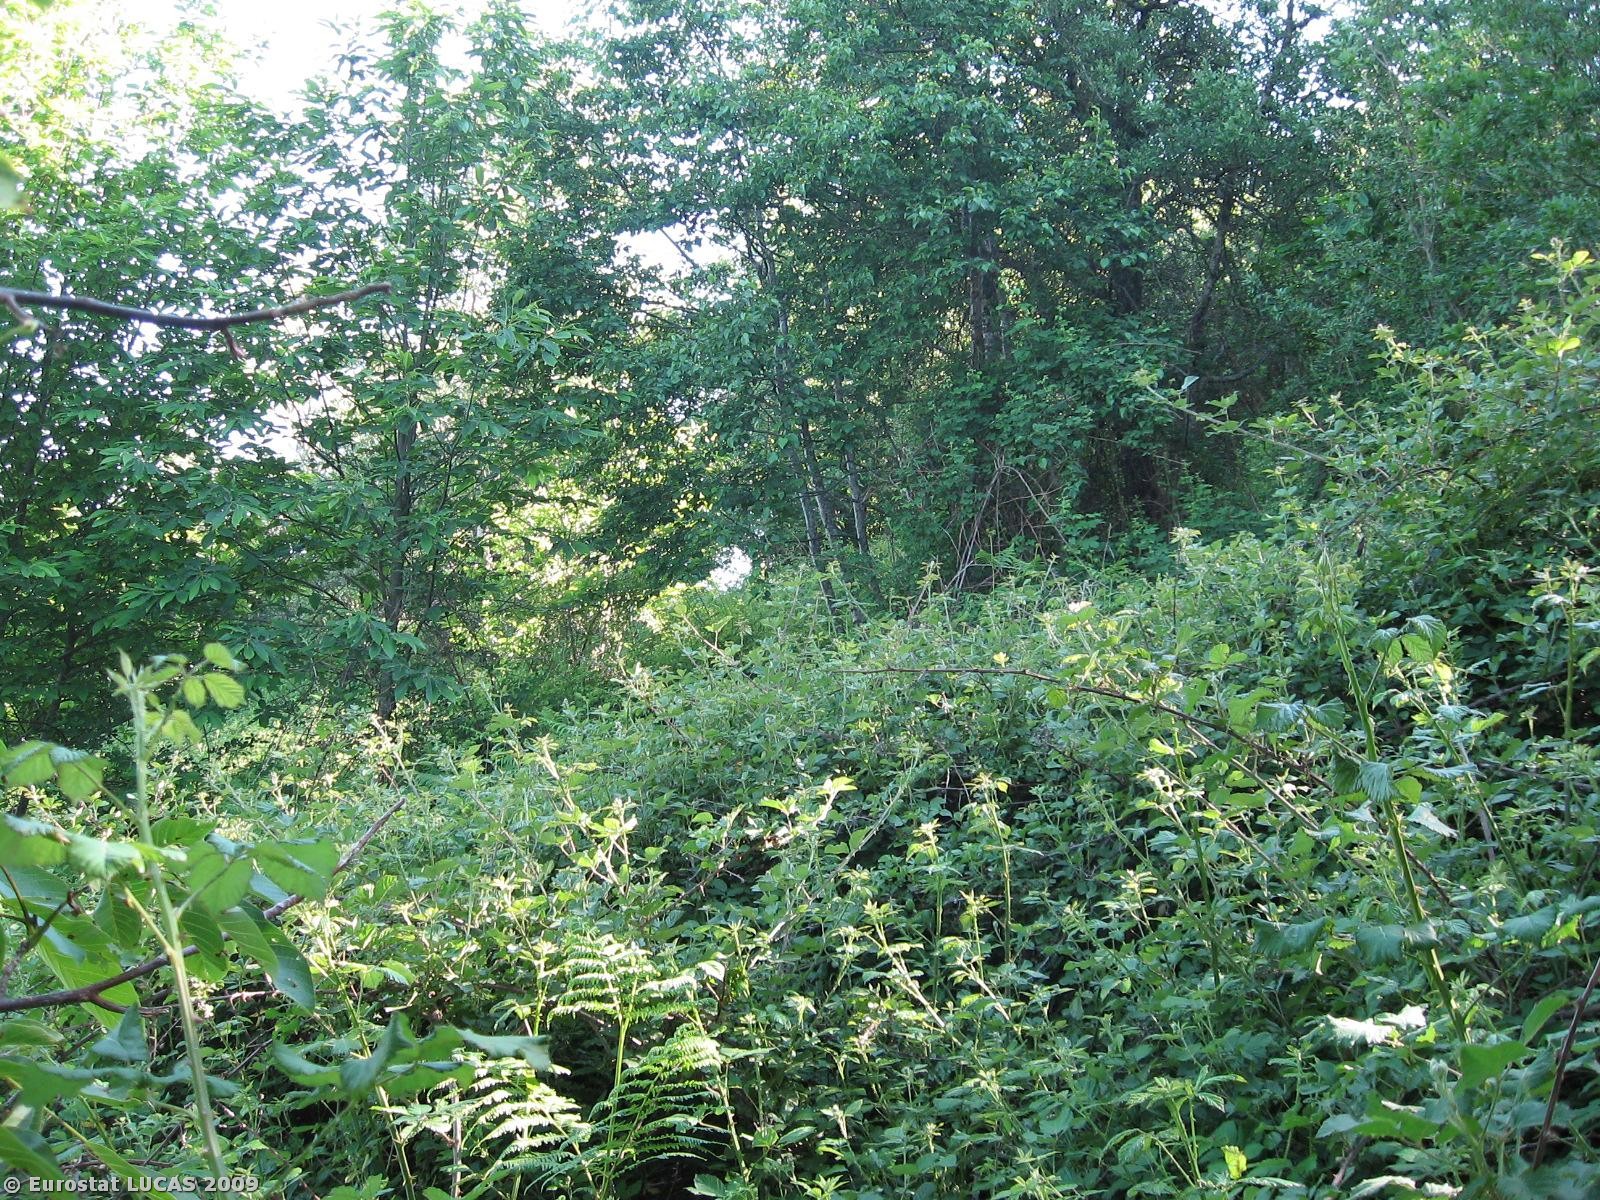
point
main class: Woodland
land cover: Broadleaved woodland
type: thermophilous deciduous forest
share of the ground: 50 - 75 %
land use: Forestry
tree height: > 5 m
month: June
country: IT
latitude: 39.0125
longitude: 16.2846
